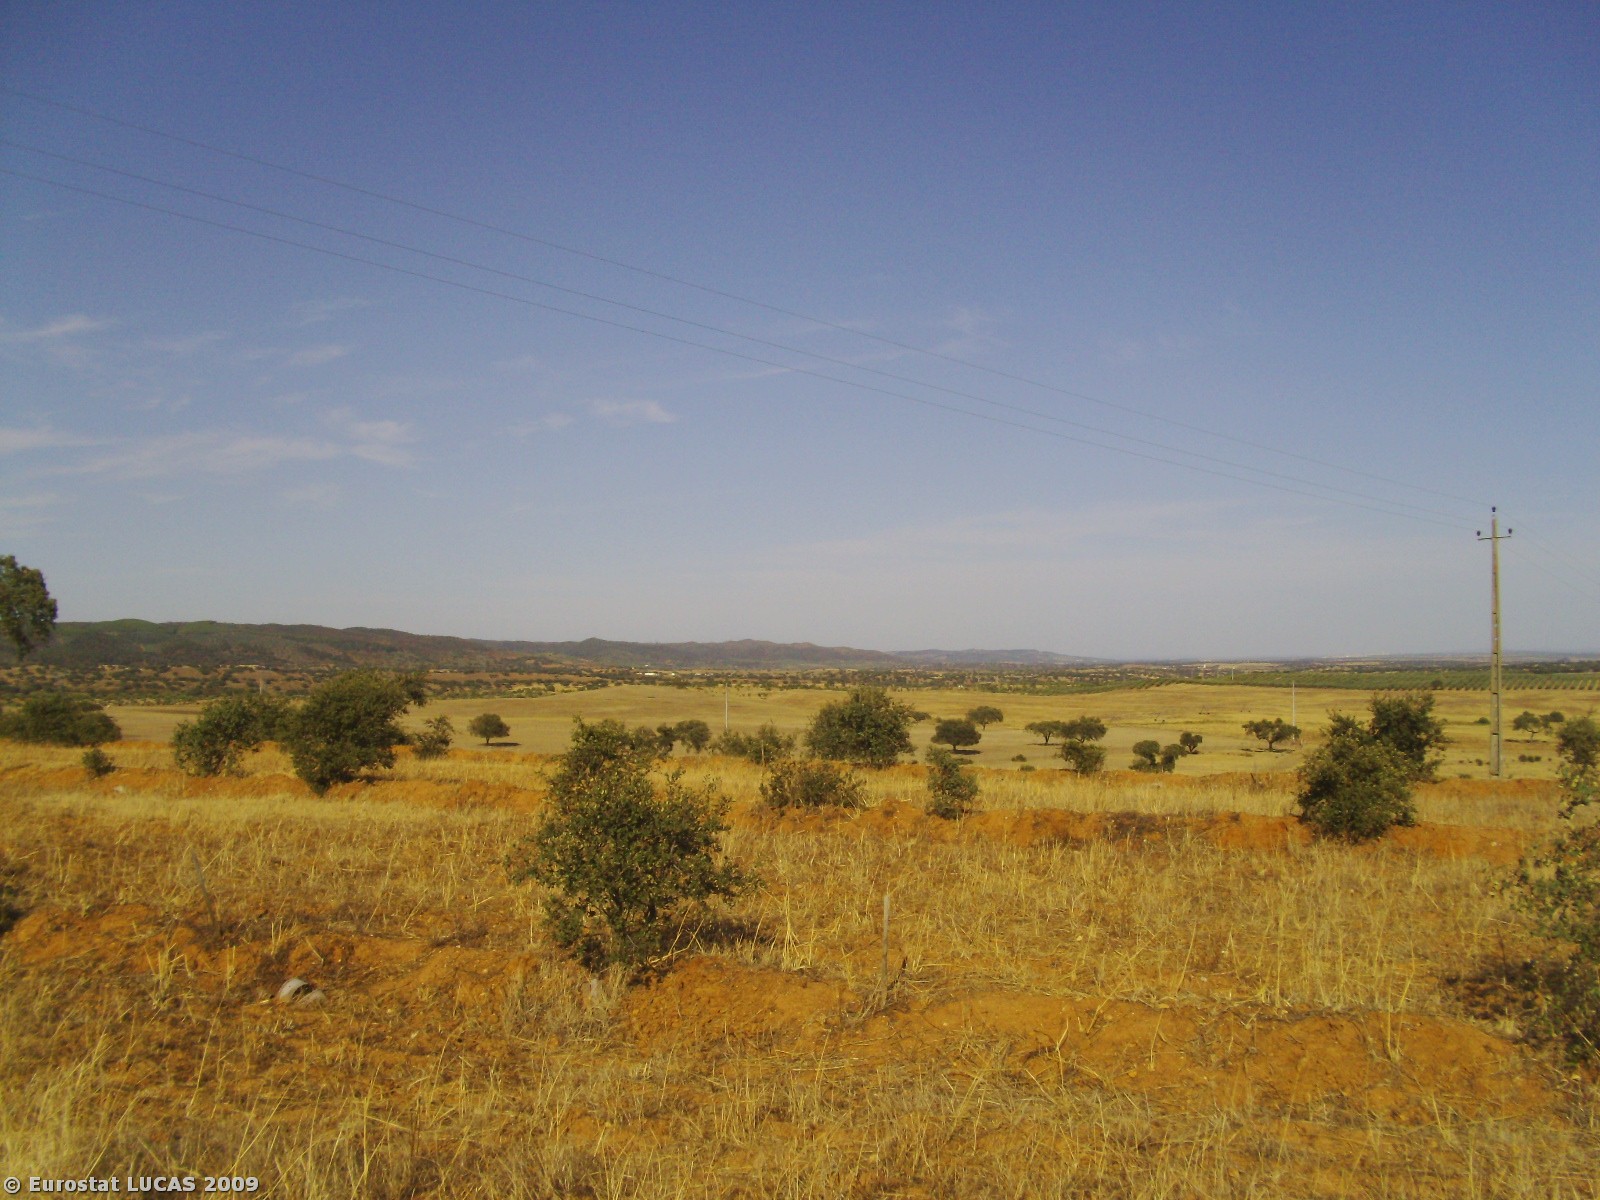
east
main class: Woodland
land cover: Broadleaved woodland
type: broadleaved evergreen forest
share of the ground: 50 - 75 %
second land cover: Spontaneously vegetated surfaces
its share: 10 - 25 %
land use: Forestry
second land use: Fallow land
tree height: > 5 m
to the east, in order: Broadleaved woodland; Spontaneously vegetated surfaces; Broadleaved woodland; Electric lines; Broadleaved woodland; Bare land; Fences; Grassland without tree/shrub cover
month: August
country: PT
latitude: 38.1753
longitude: -7.7328
